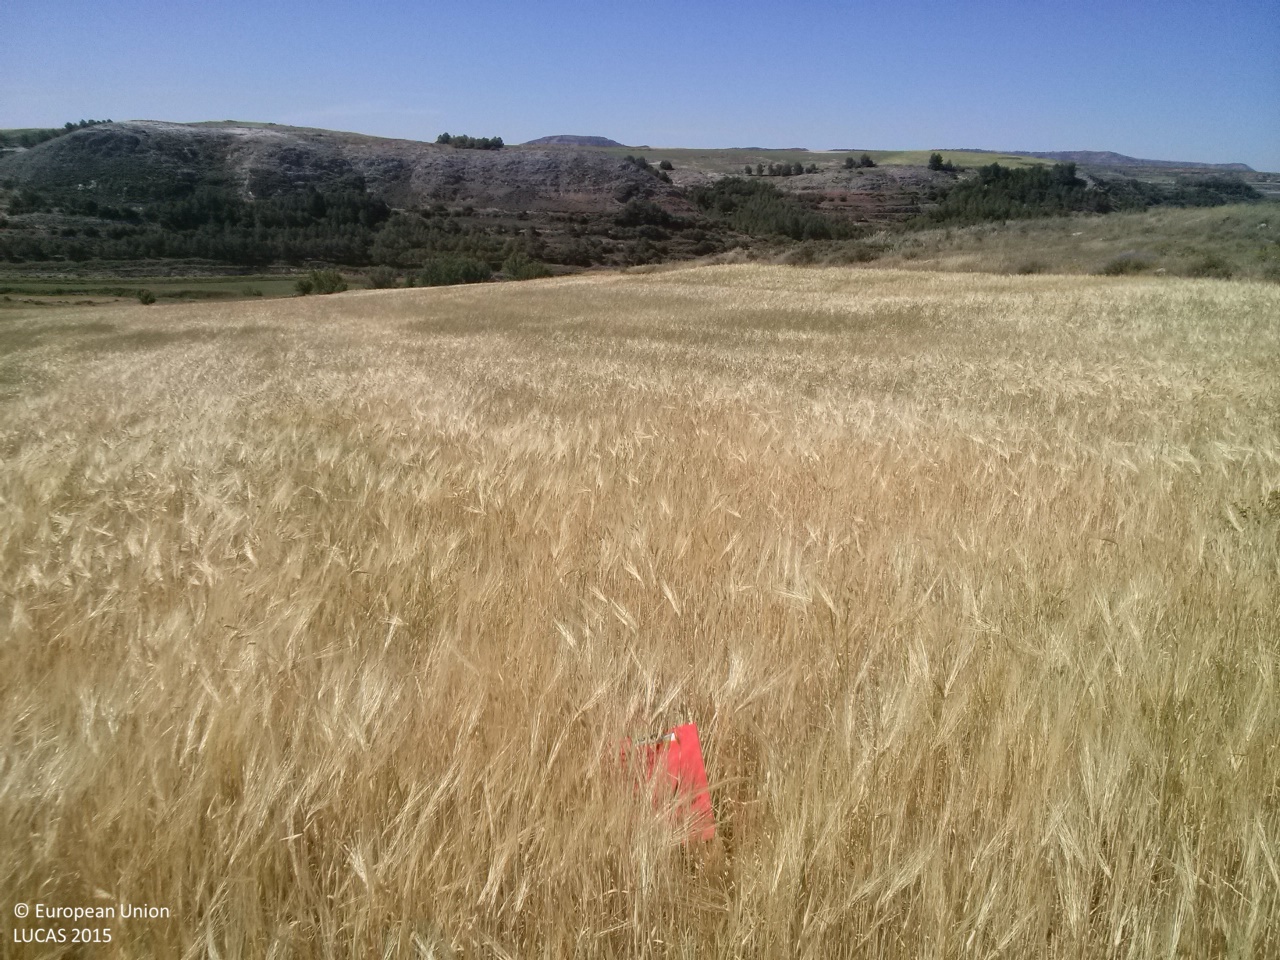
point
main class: Cropland
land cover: Barley
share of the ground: > 75 %
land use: Agriculture (excluding fallow land and kitchen gardens)
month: May
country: ES
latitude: 40.3285
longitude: -2.6054
